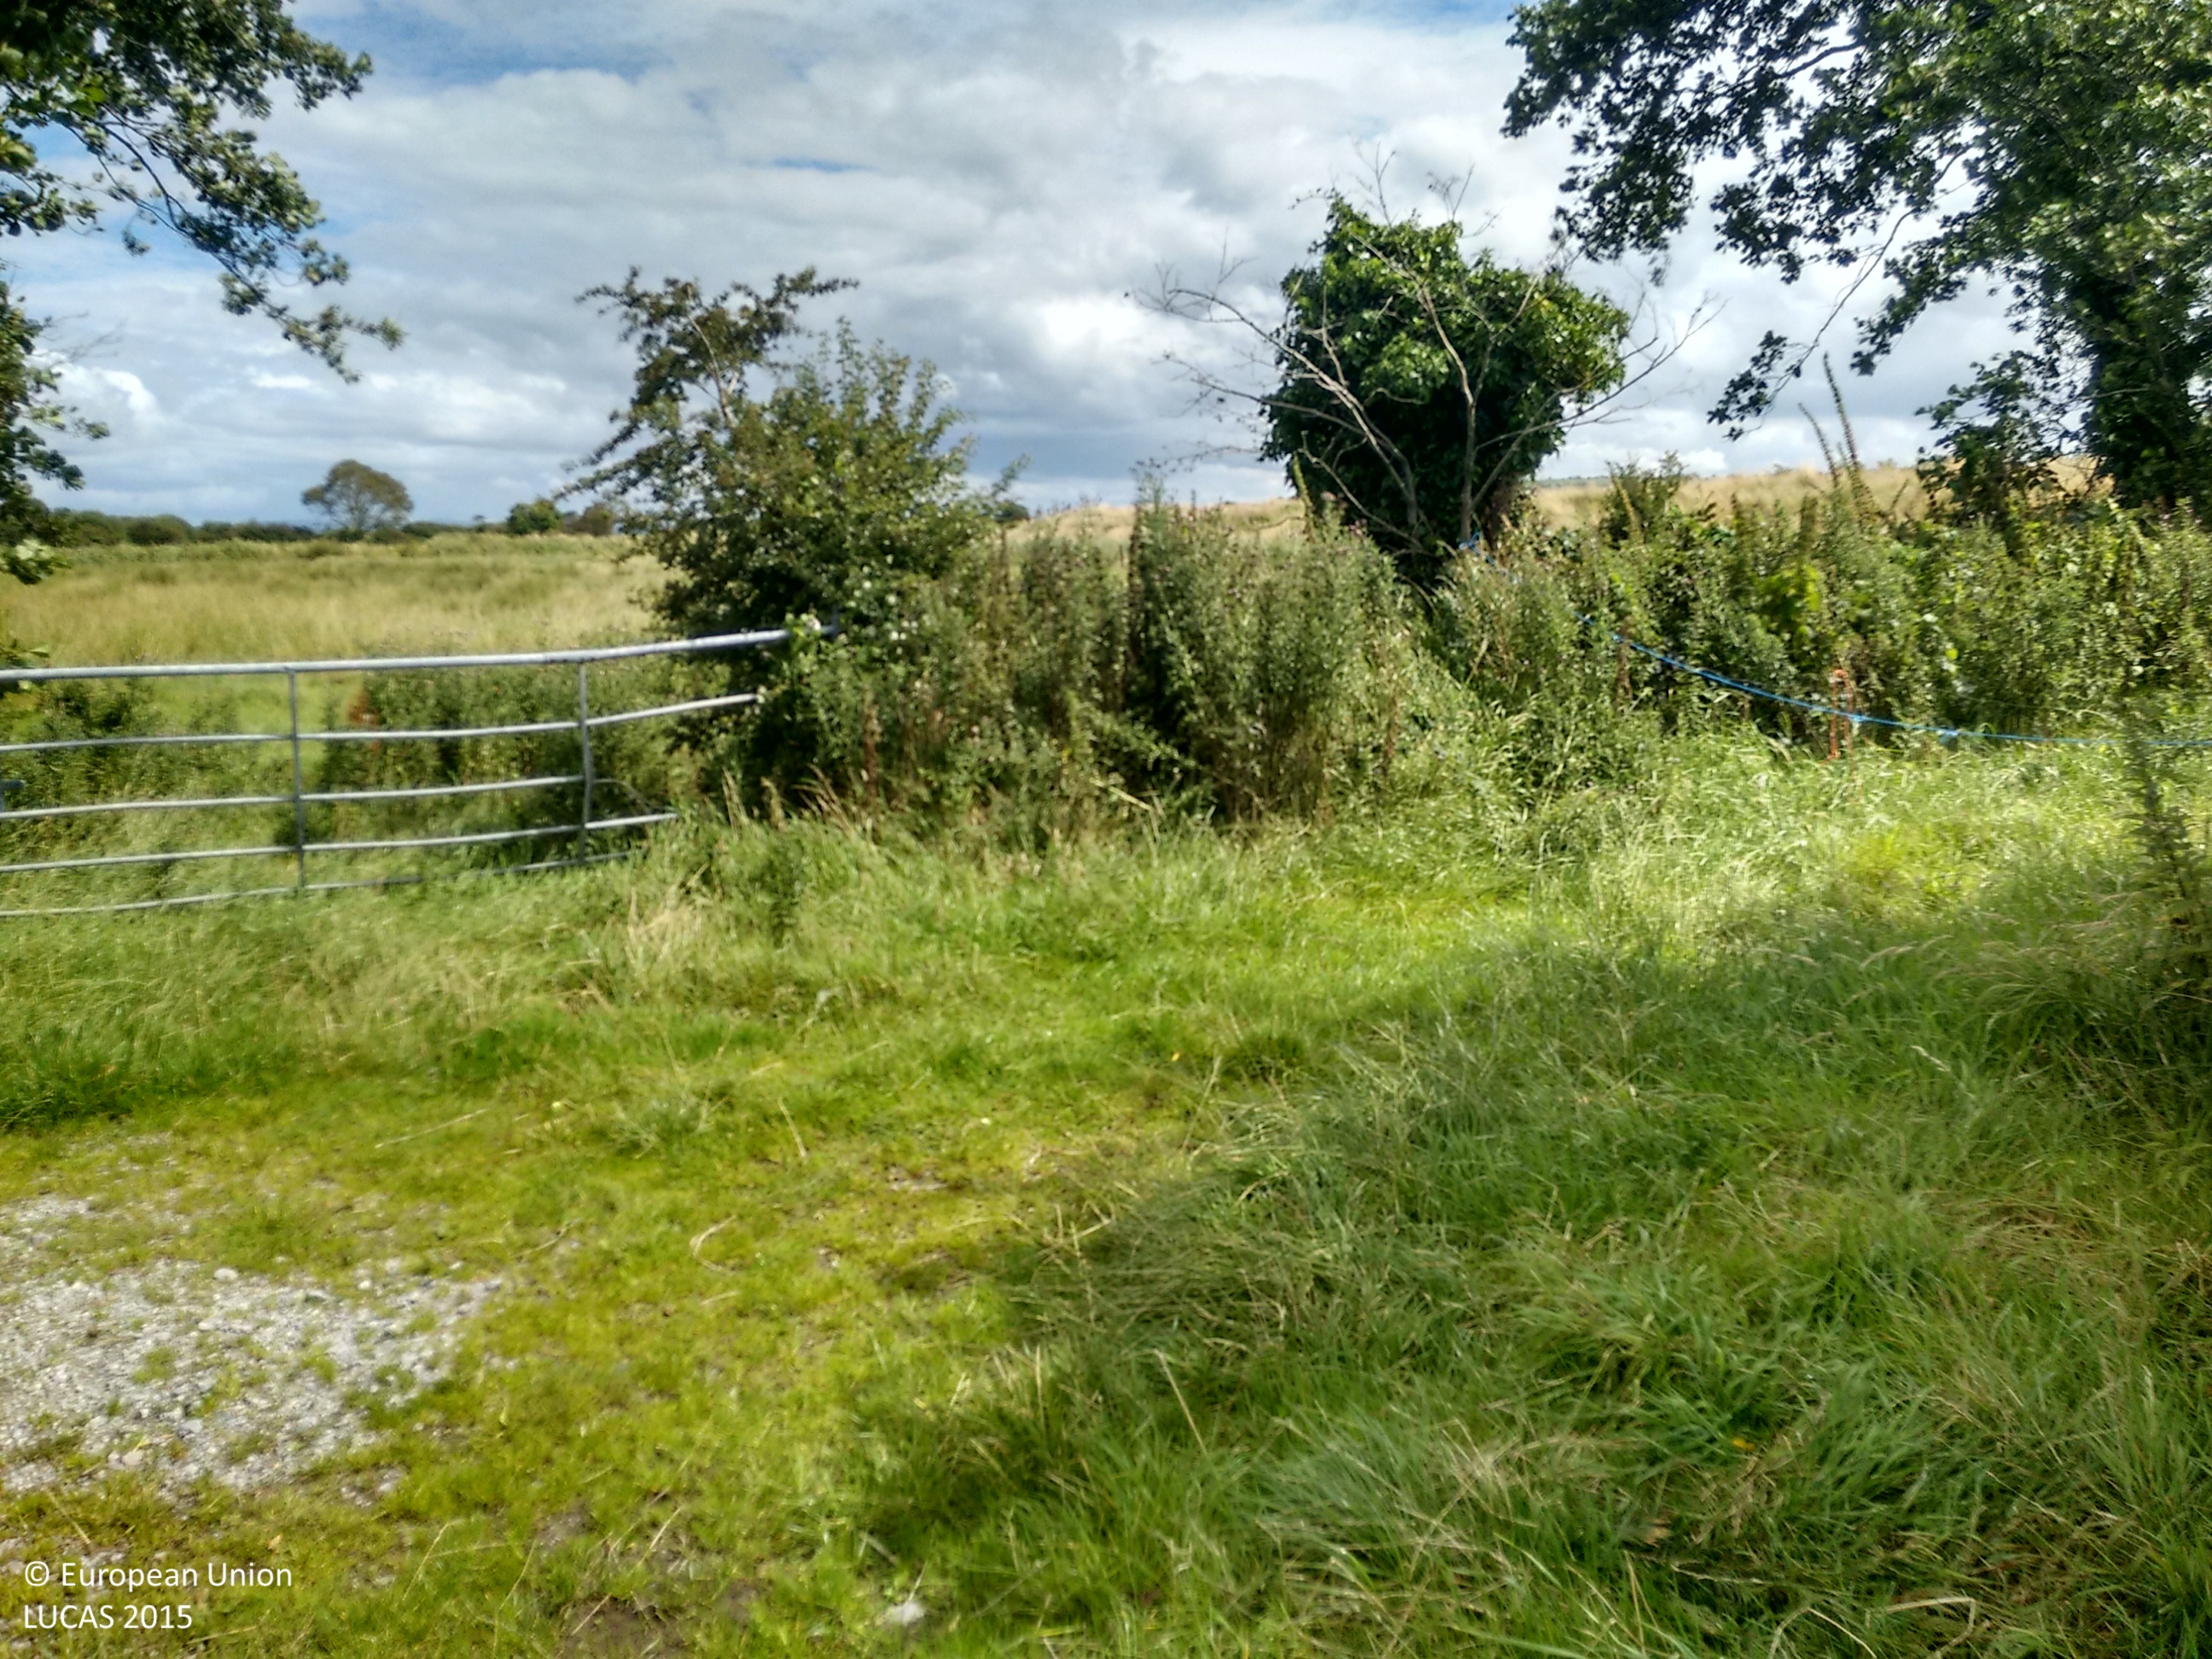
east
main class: Grassland
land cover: Grassland without tree/shrub cover
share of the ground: > 75 %
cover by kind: herbaceous plants 100 %
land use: Agriculture (excluding fallow land and kitchen gardens)
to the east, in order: Grassland without tree/shrub cover; Ditches and canals; Abandoned hedges; Grassland without tree/shrub cover; Abandoned hedges; Grassland without tree/shrub cover; Inland marshes
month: August
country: IE
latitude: 52.1616
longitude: -9.7292
